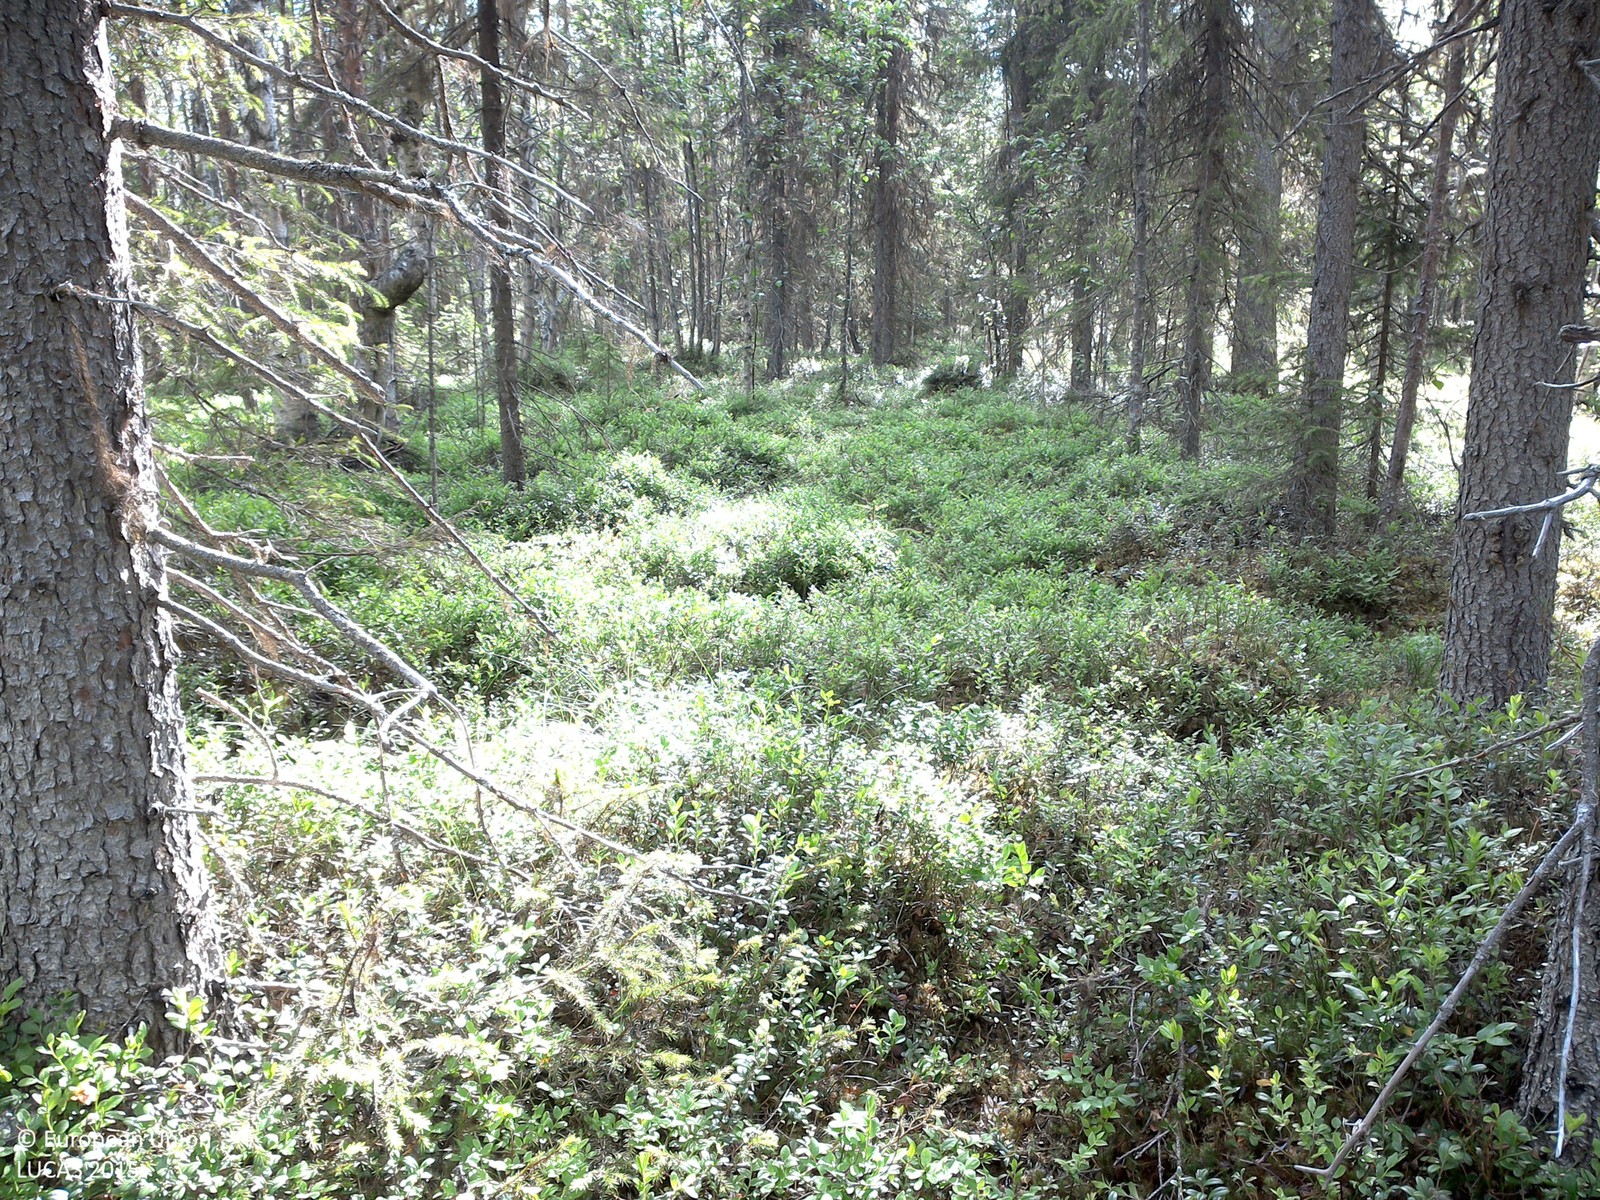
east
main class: Woodland
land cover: Spruce dominated mixed woodland
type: boreal forest
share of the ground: 25 - 50 %
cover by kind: shrubs 55 %, coniferous forest trees 30 %, broadleaved forest trees 10 %, lichens and mosses 5 %
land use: Forestry
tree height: > 5 m
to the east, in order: Spruce dominated mixed woodland; Pine dominated mixed woodland; Broadleaved woodland; Electric lines; Broadleaved woodland; Pine dominated mixed woodland; Ditches and canals; Pine dominated mixed woodland; Spruce dominated mixed woodland; Ditches and canals; Spruce dominated mixed woodland
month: July
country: SE
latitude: 67.1392
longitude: 22.6744
